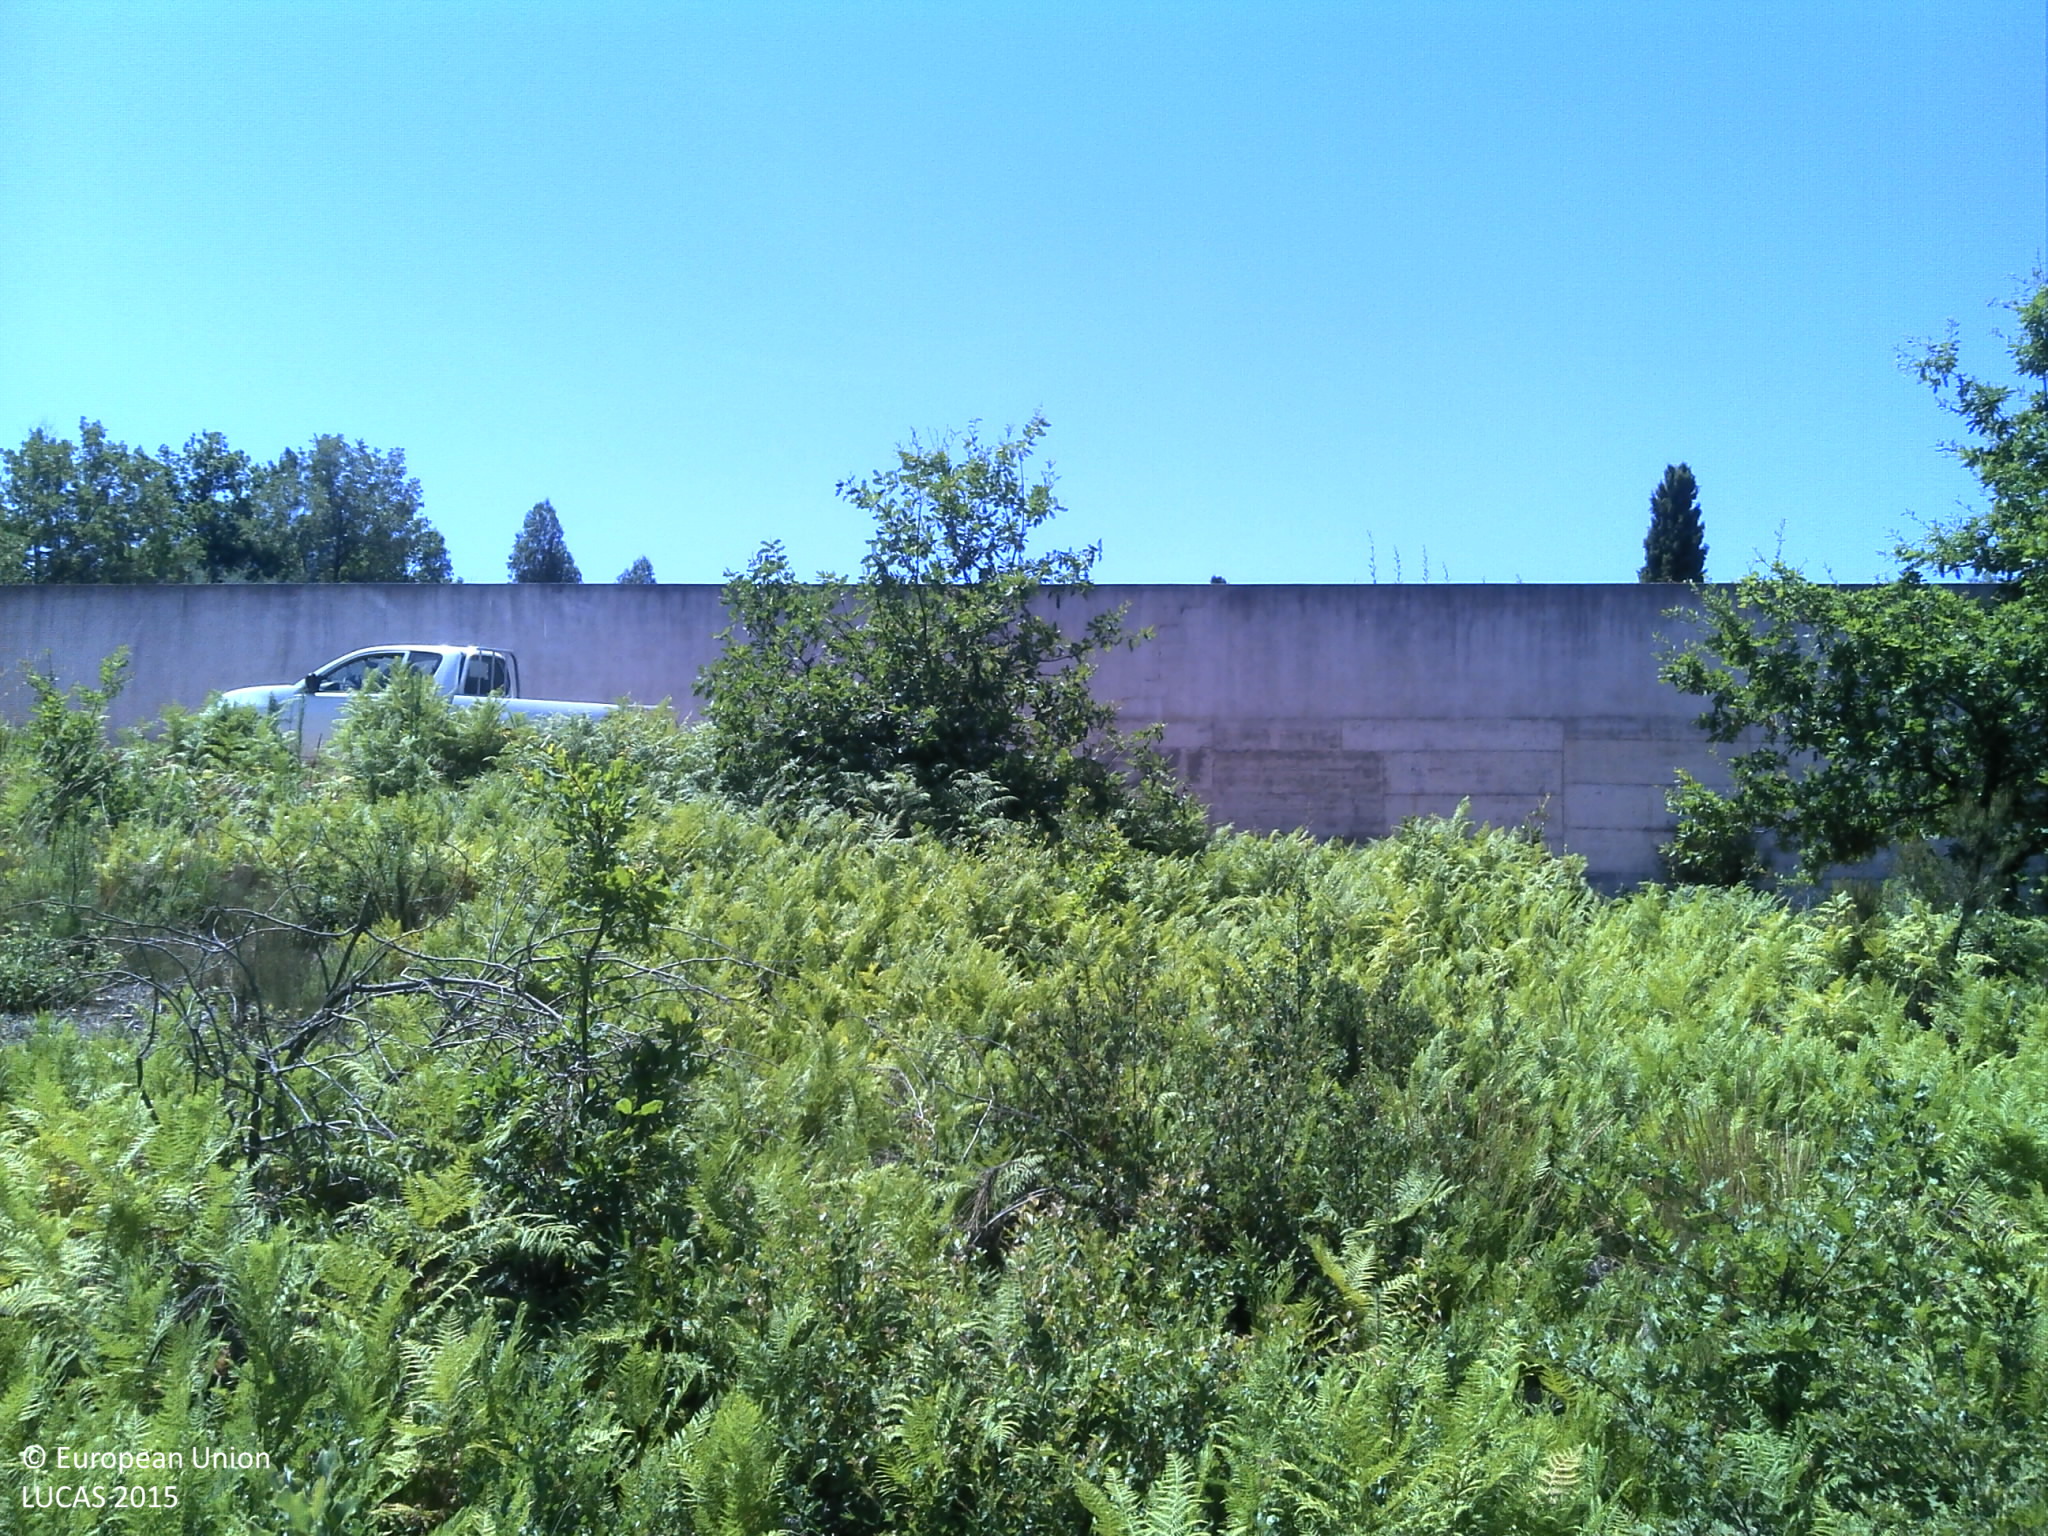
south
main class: Grassland
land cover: Grassland with sparse tree/shrub cover
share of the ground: > 75 %
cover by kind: herbaceous plants 50 %, unconsolidated bare surface 40 %, broadleaved forest trees 5 %, shrubs 5 %
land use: Forestry
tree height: < 5 m
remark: Clear cut
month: July
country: PT
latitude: 40.2717
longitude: -7.9829
